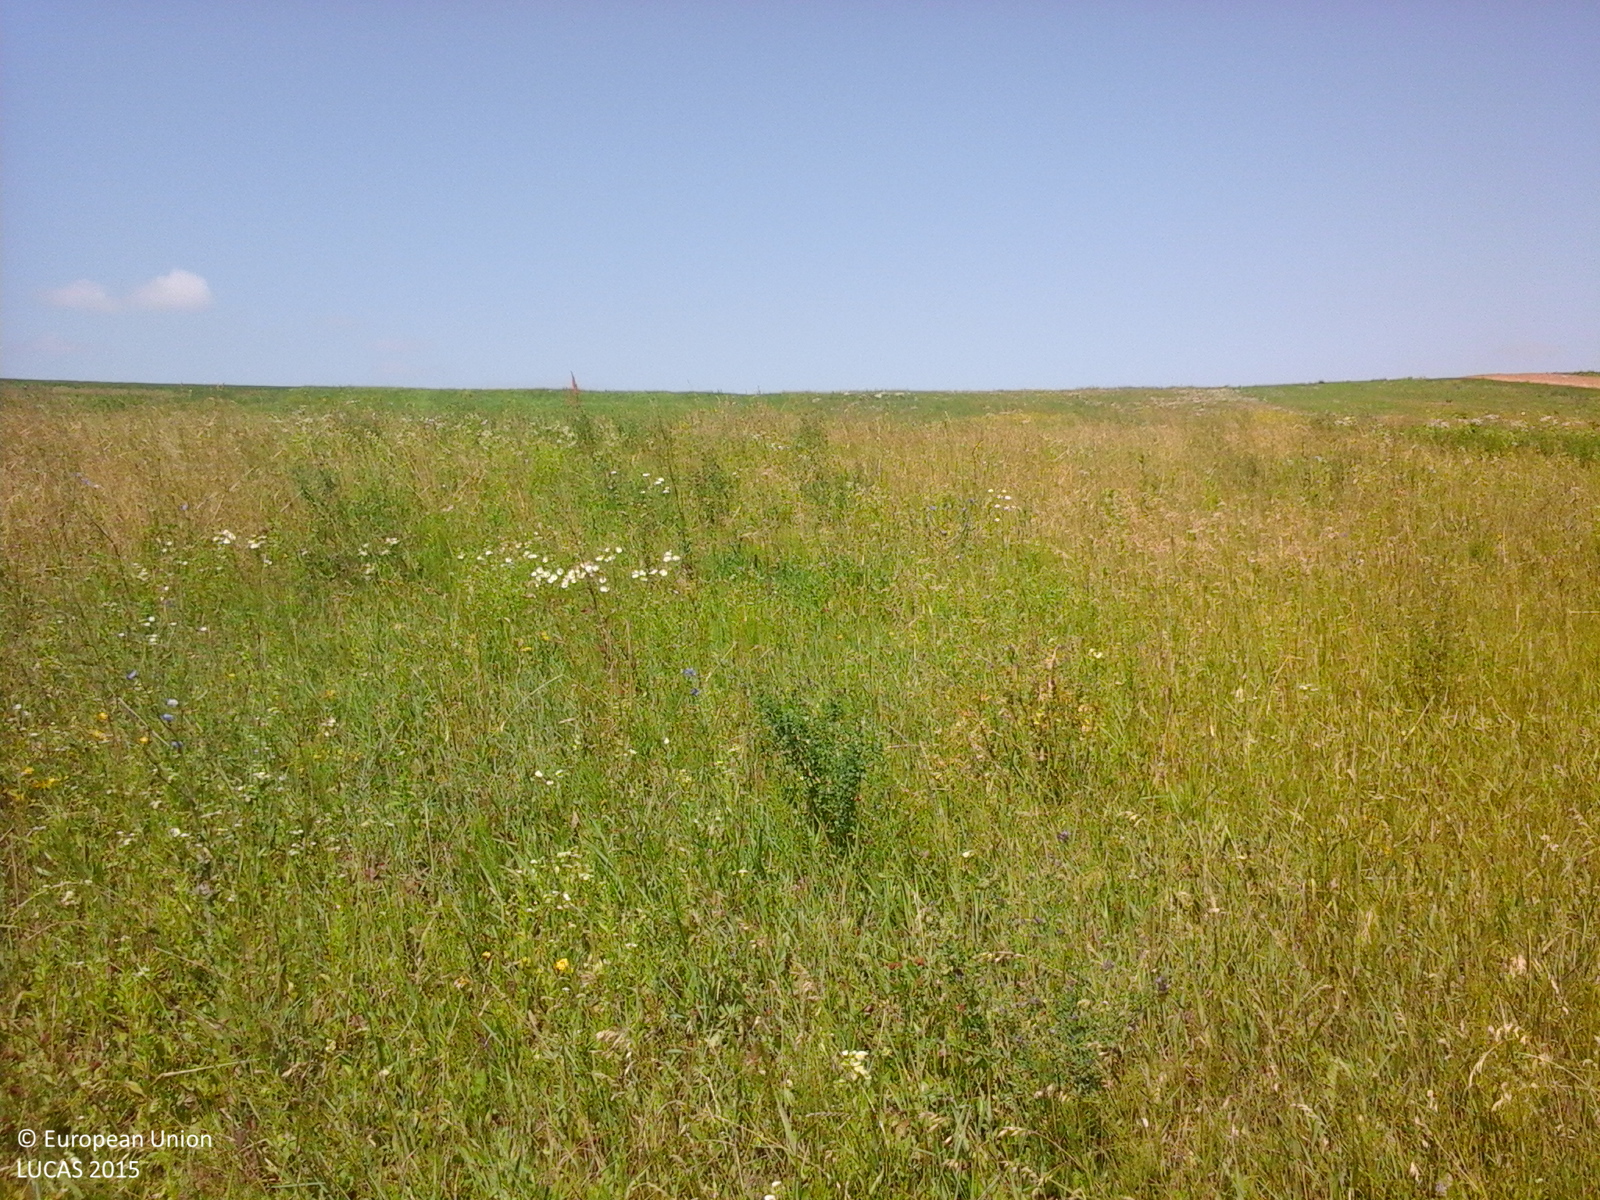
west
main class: Grassland
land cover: Grassland without tree/shrub cover
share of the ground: > 75 %
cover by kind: herbaceous plants 100 %
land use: Agriculture (excluding fallow land and kitchen gardens)
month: June
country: RO
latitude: 46.7199
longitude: 27.2569
